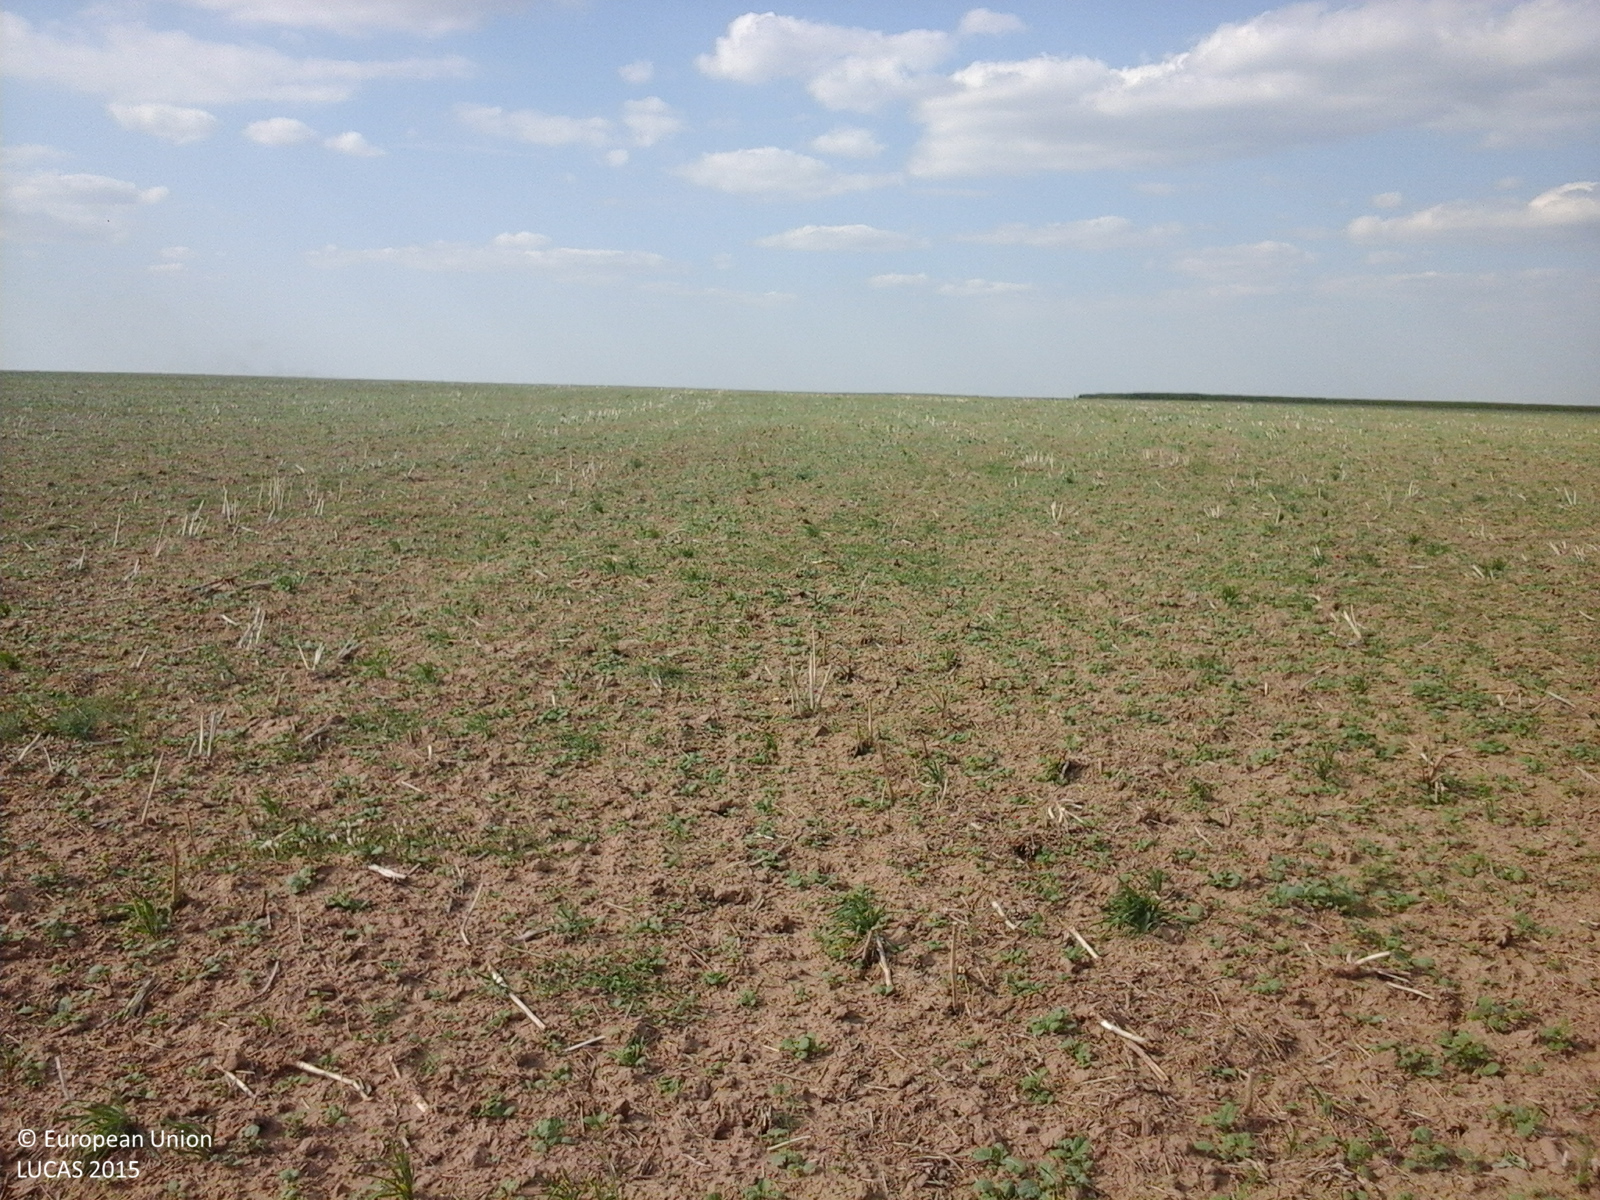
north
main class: Cropland
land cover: Rape and turnip rape
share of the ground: 10 - 25 %
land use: Agriculture (excluding fallow land and kitchen gardens)
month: August
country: RO
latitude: 44.7510
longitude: 28.1133
